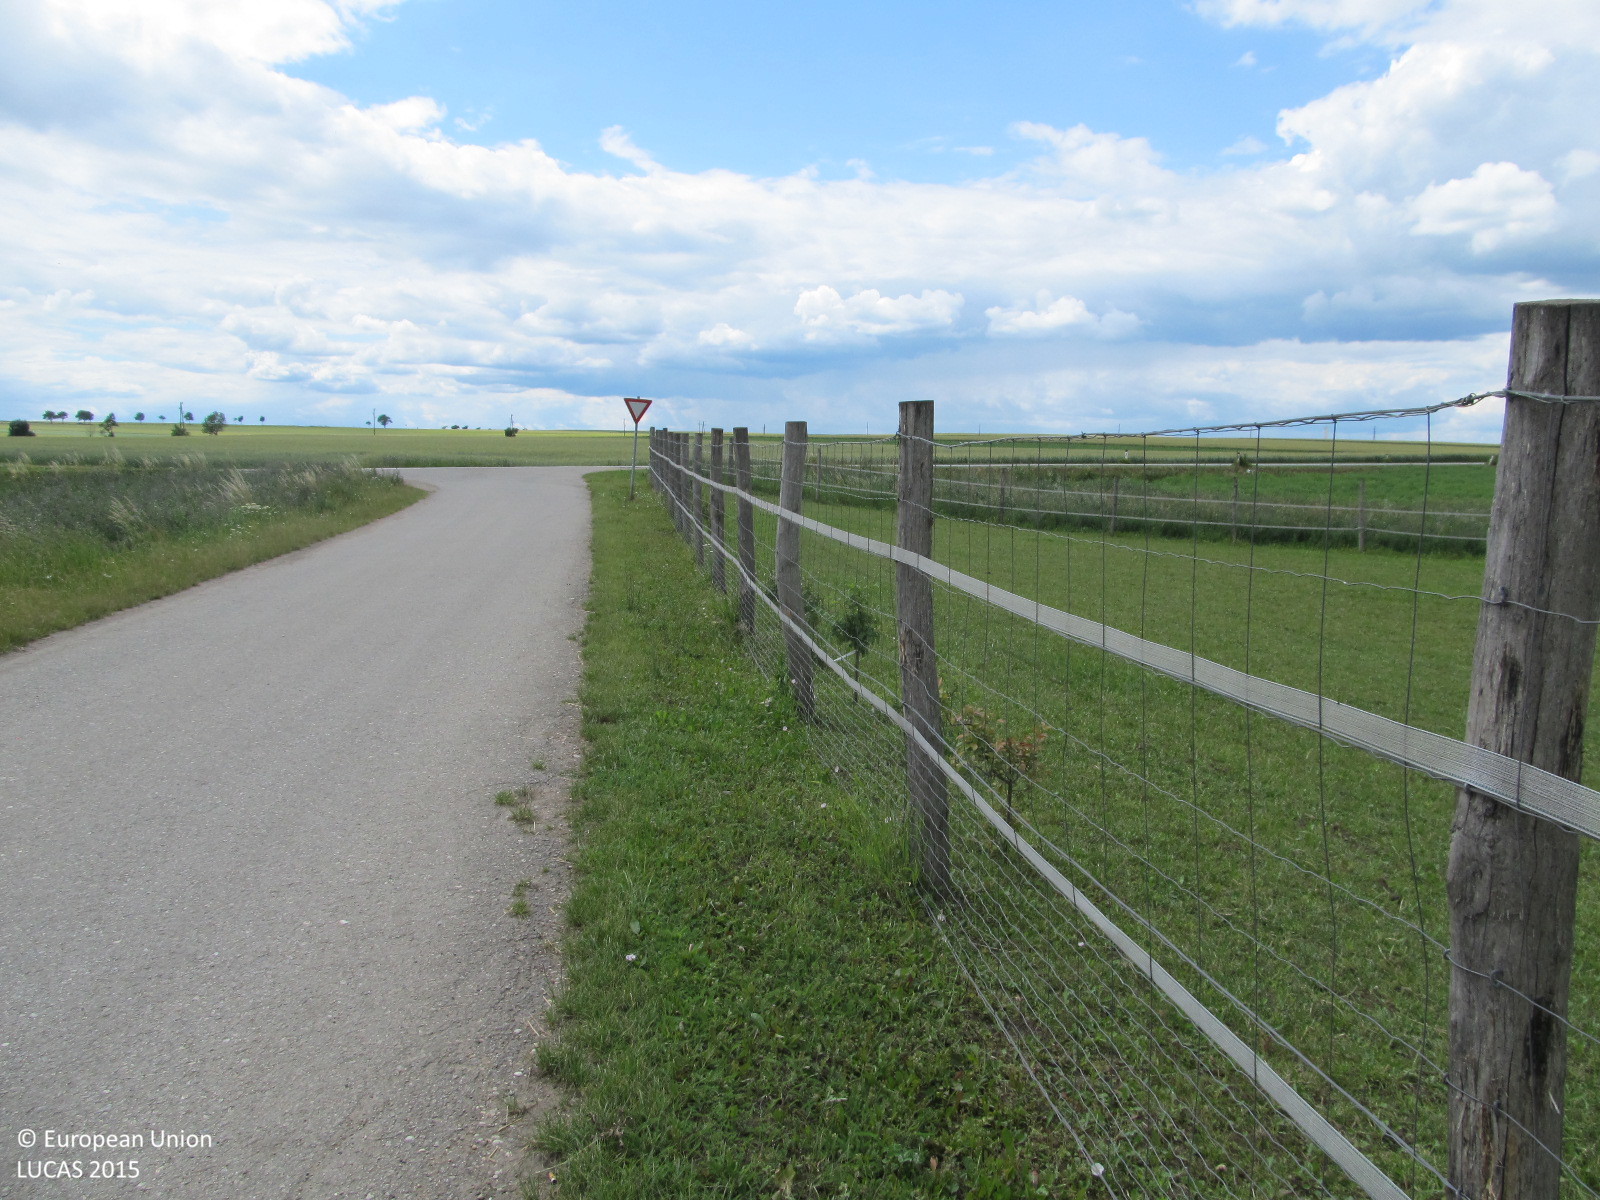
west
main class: Grassland
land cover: Grassland without tree/shrub cover
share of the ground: > 75 %
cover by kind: herbaceous plants 100 %
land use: Agriculture (excluding fallow land and kitchen gardens)
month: June
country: AT
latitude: 48.6322
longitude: 16.0972
